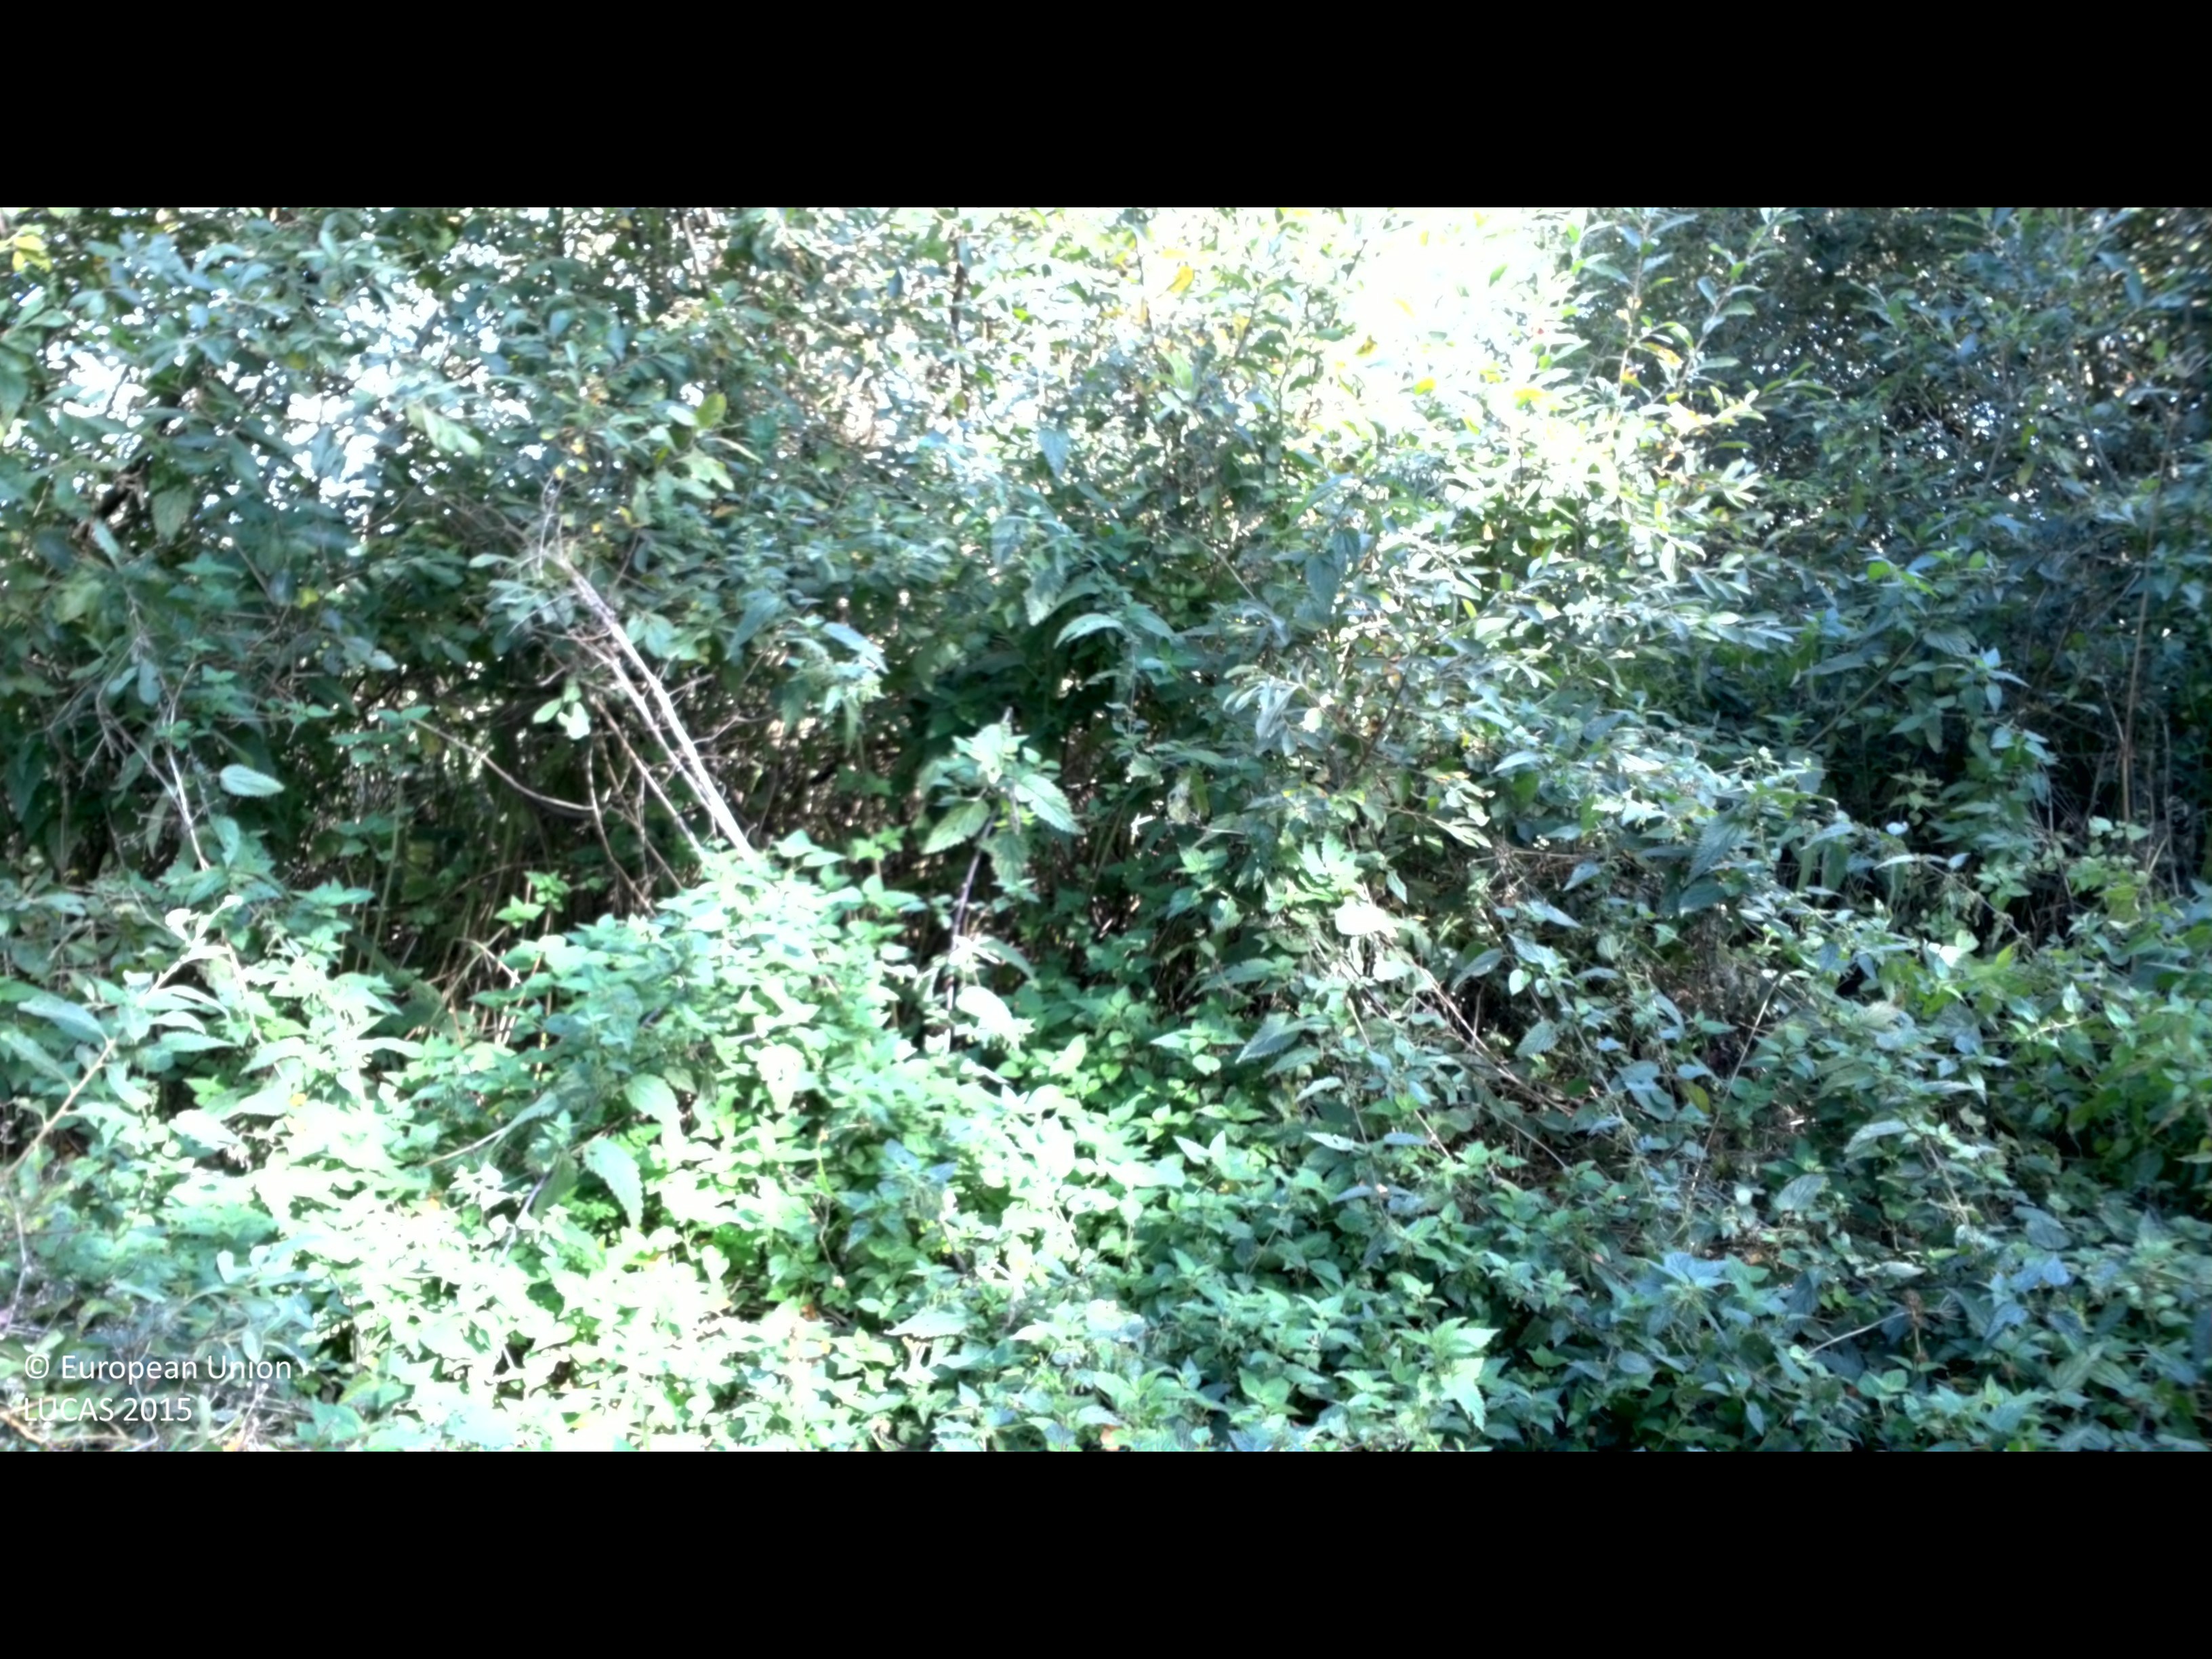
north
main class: Woodland
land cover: Broadleaved woodland
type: hemiboreal forest and nemoral coniferous forest and mixed broadleaved-coniferous forest
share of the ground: > 75 %
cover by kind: broadleaved forest trees 75 %, herbaceous plants 25 %
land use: Forestry
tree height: < 5 m
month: September
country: SE
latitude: 56.0242
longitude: 14.3462
